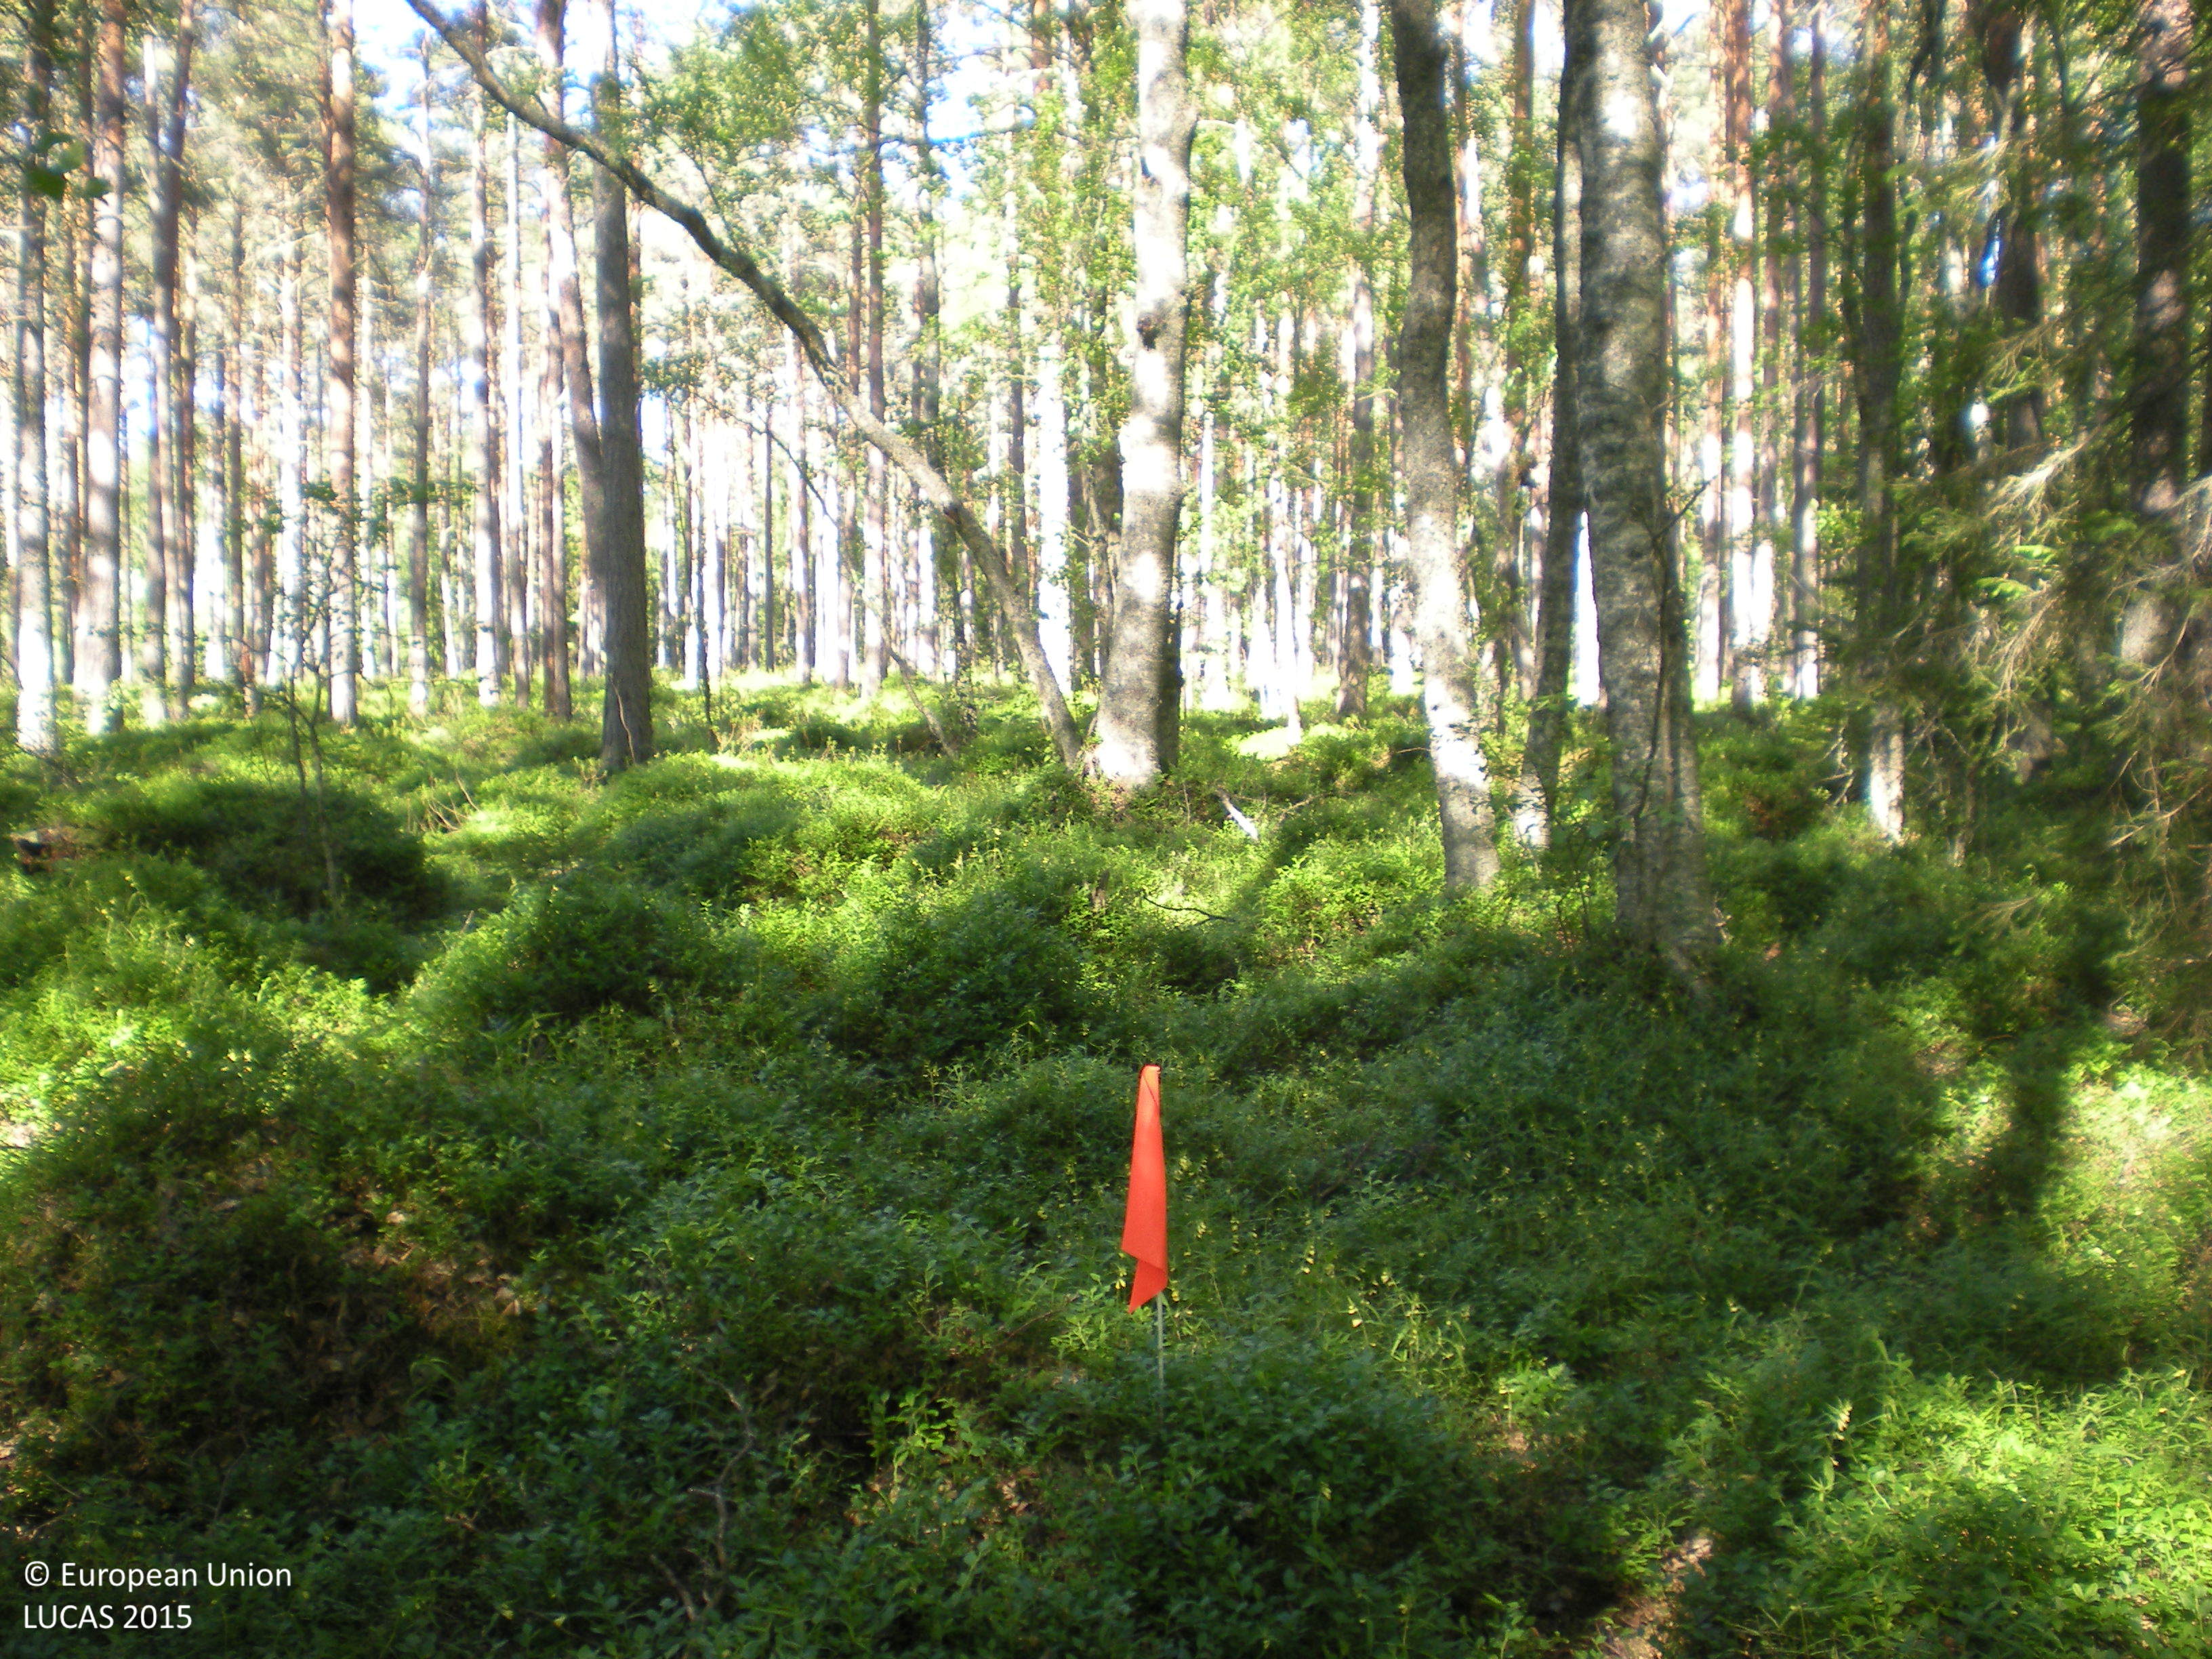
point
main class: Woodland
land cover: Pine dominated mixed woodland
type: boreal forest
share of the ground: 50 - 75 %
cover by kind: coniferous forest trees 60 %, broadleaved forest trees 20 %, shrubs 15 %, herbaceous plants 5 %
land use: Forestry
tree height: > 5 m
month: July
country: SE
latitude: 60.5274
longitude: 17.7720
